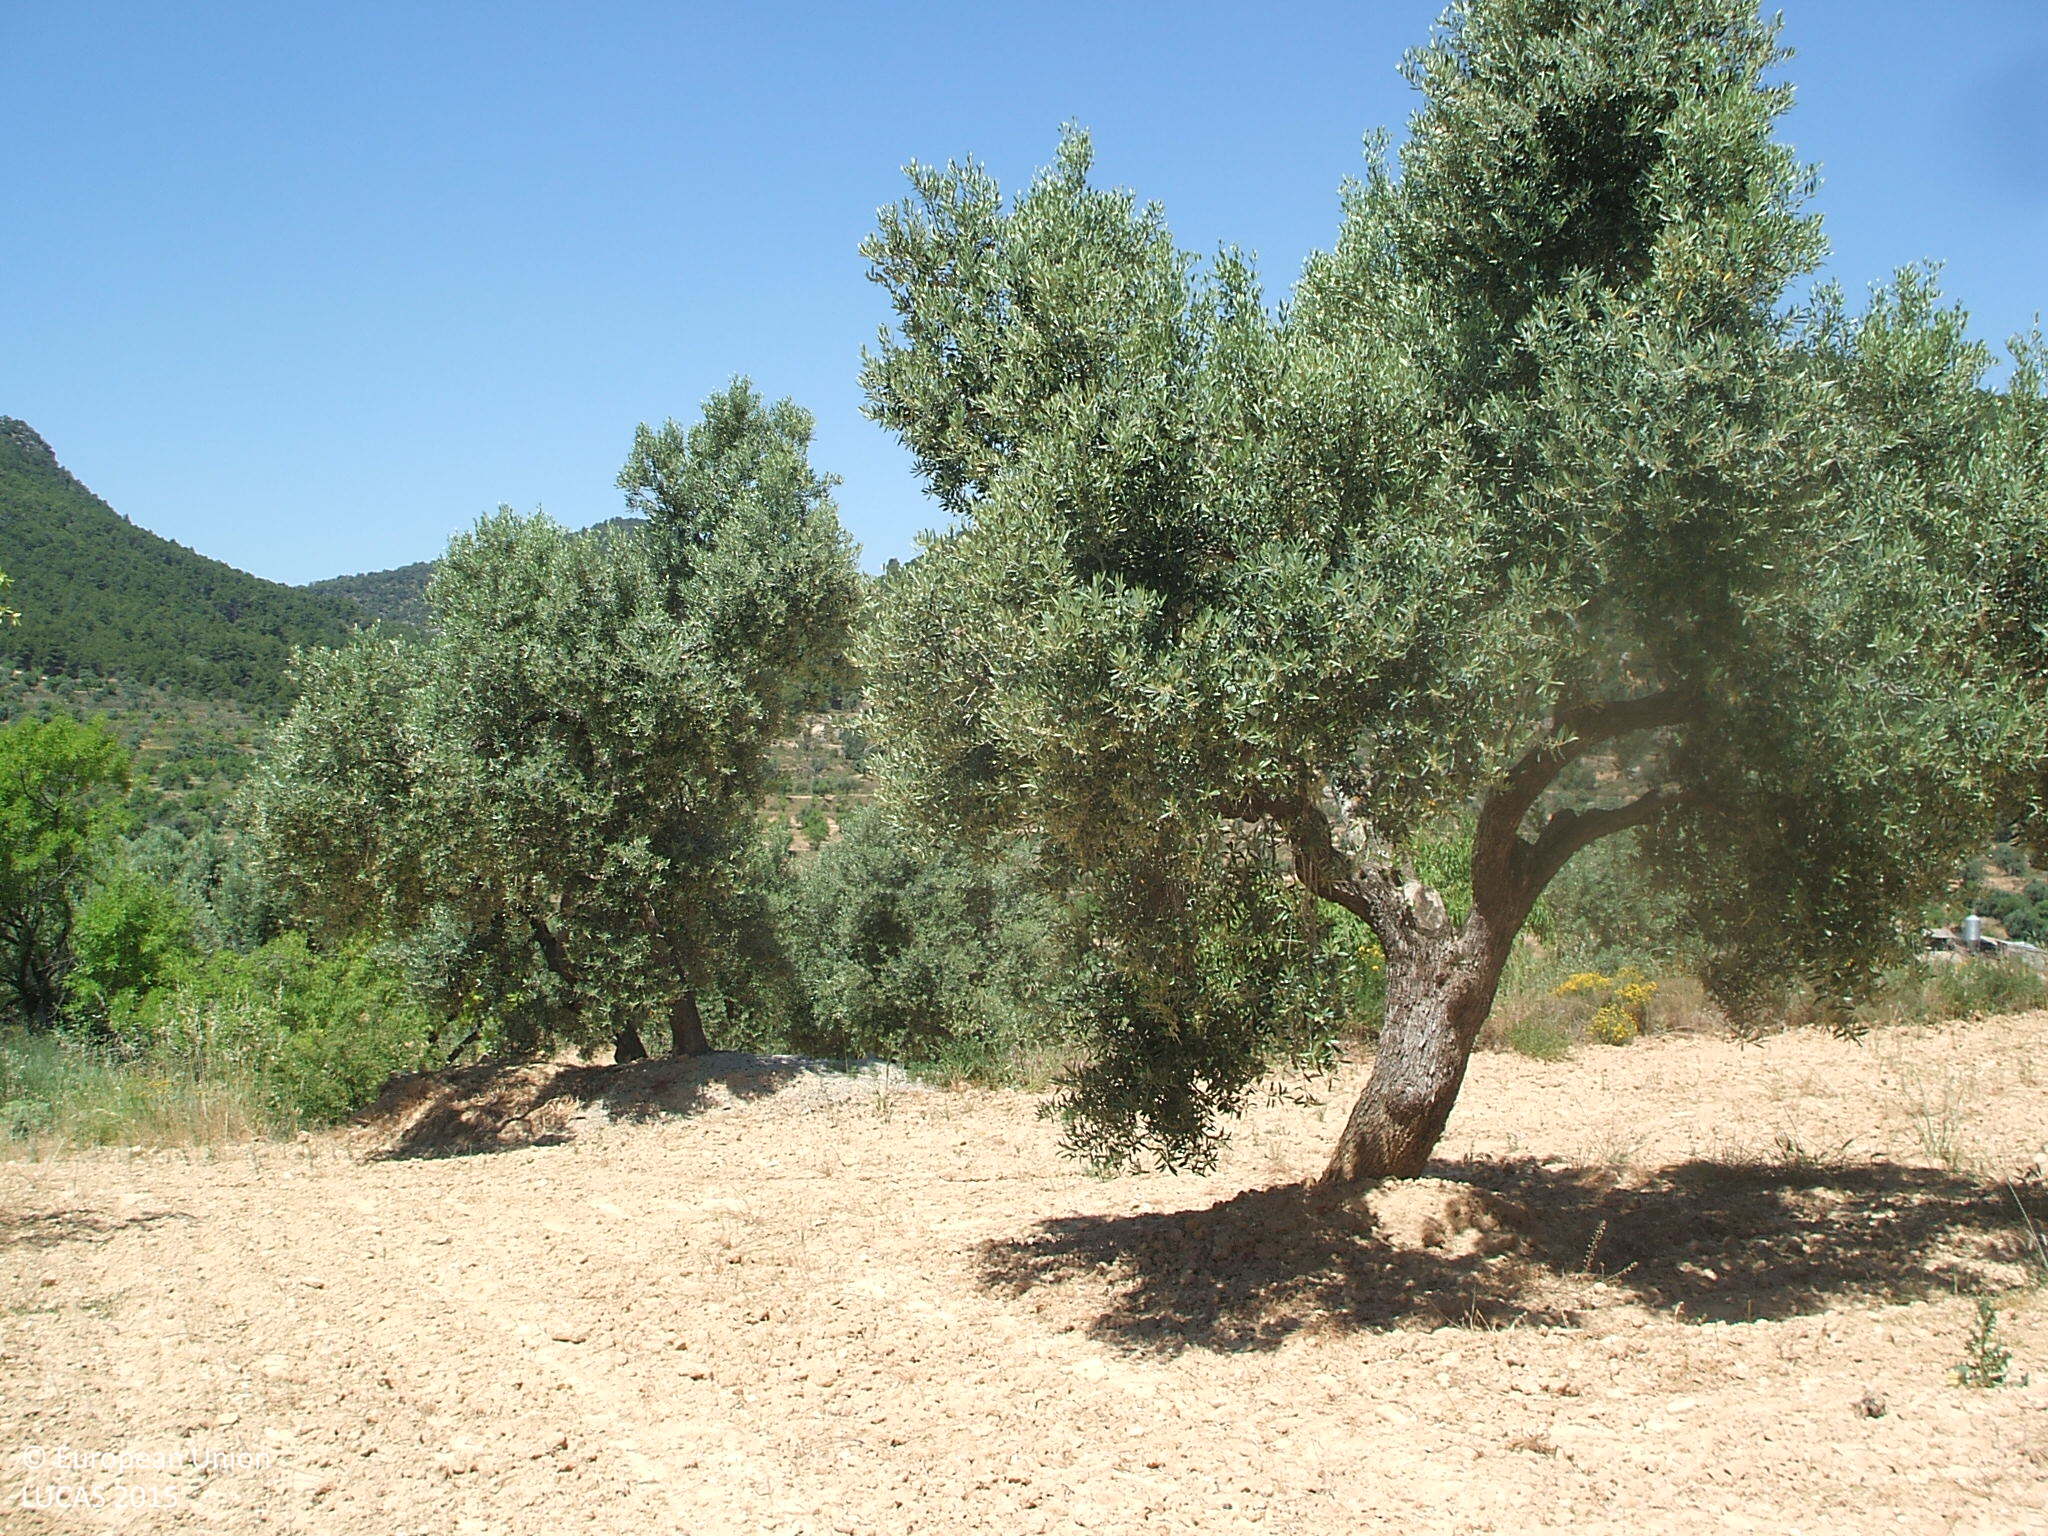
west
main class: Cropland
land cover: Olive groves
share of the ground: 10 - 25 %
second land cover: Other bare soil
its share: > 75 %
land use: Agriculture (excluding fallow land and kitchen gardens)
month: June
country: ES
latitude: 40.8316
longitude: 0.0185
